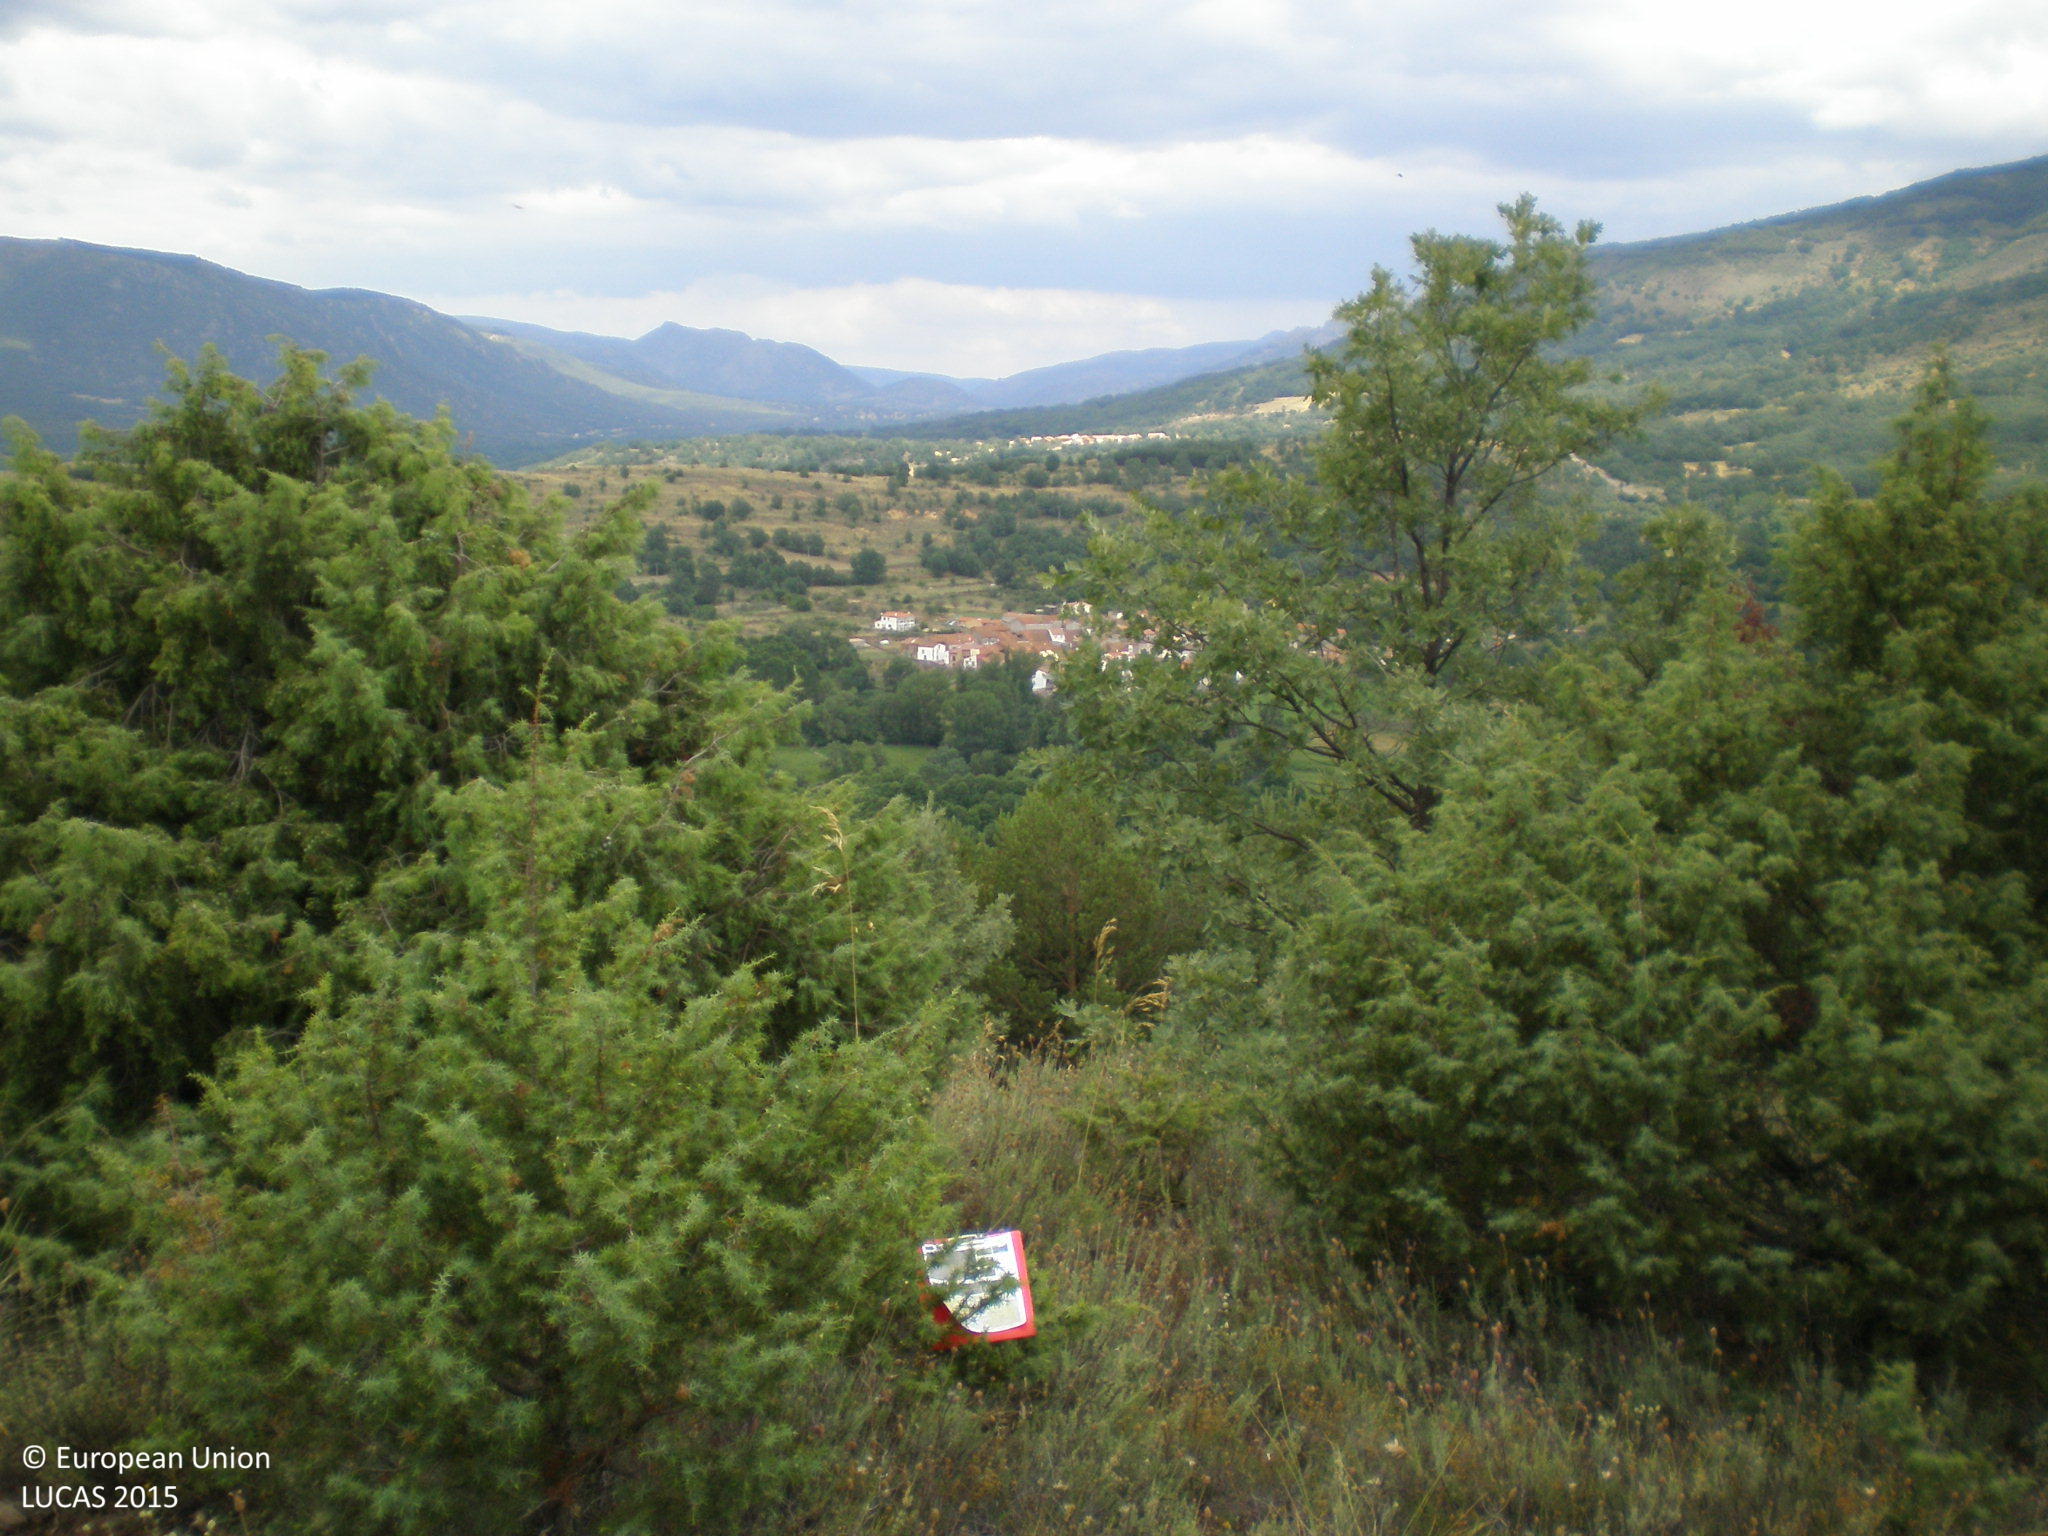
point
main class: Shrubland
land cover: Shrubland without tree cover
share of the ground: > 75 %
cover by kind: shrubs 100 %
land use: Semi-natural and natural areas not in use
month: June
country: ES
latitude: 40.3114
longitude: -5.5147
